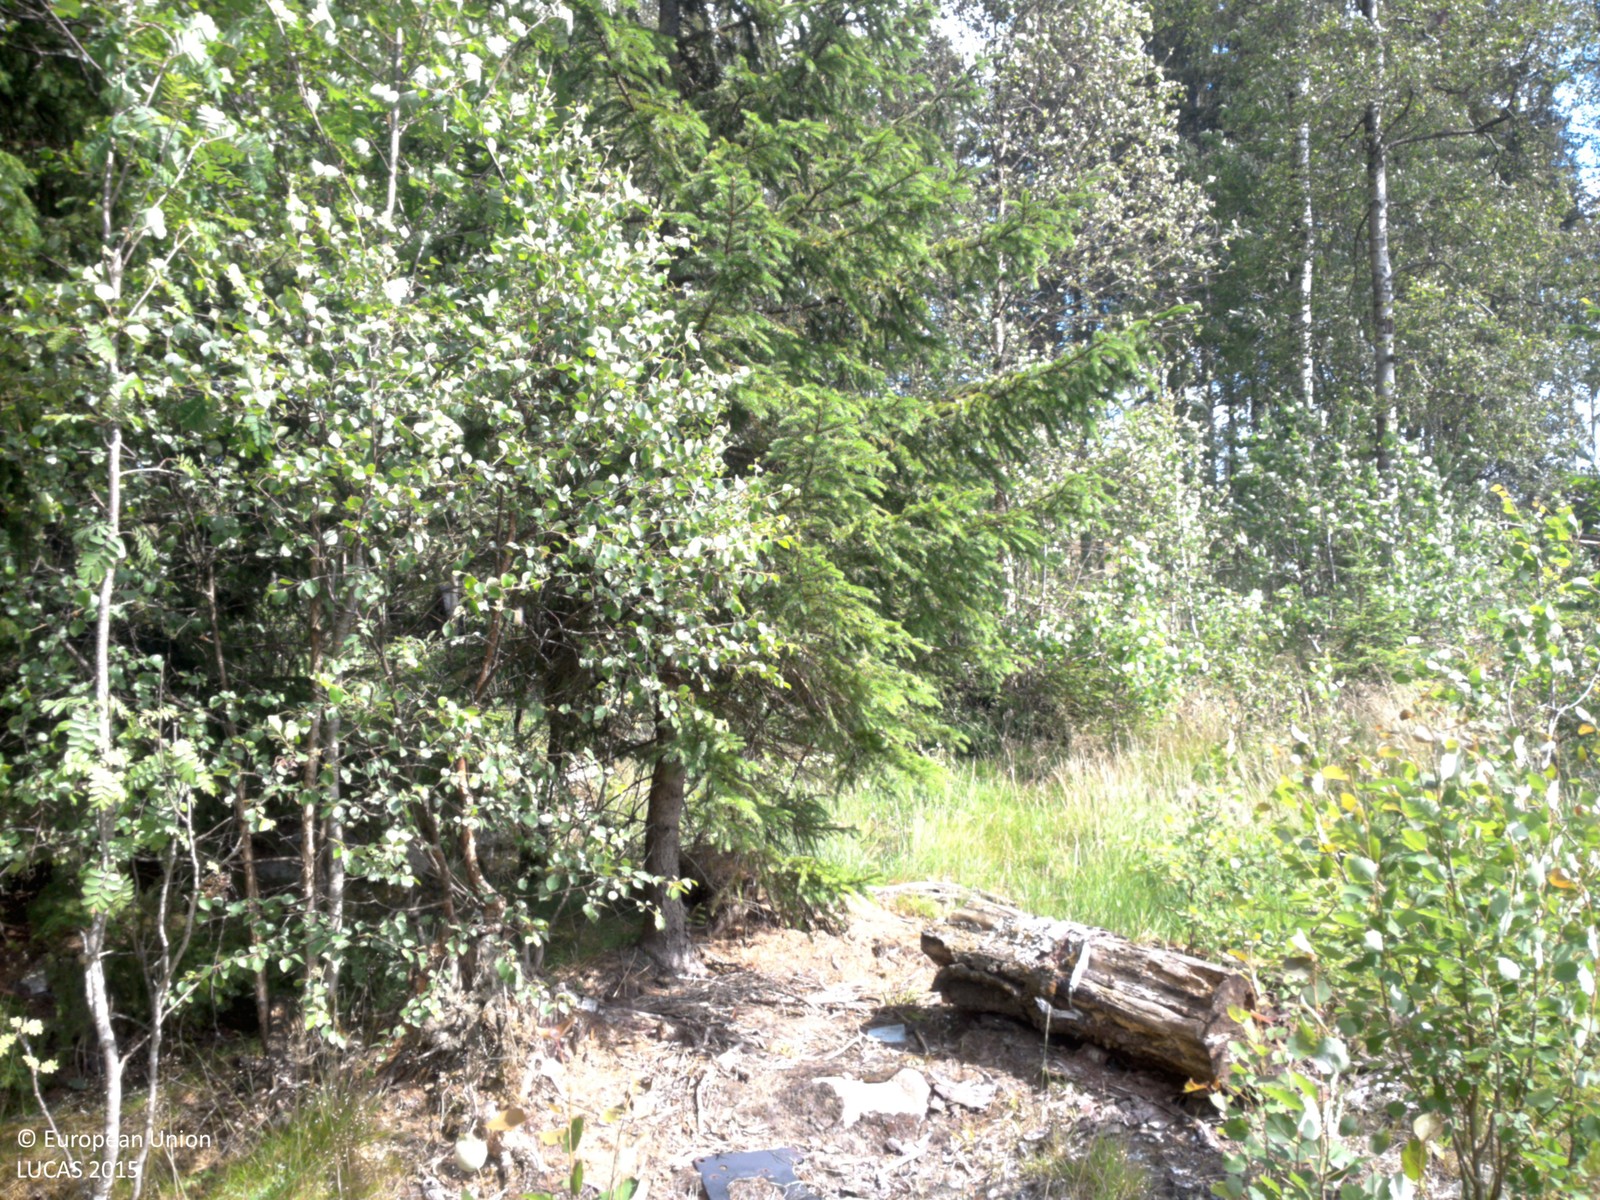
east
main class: Grassland
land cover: Grassland without tree/shrub cover
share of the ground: 50 - 75 %
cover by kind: herbaceous plants 65 %, unconsolidated bare surface 20 %, consolidated bare surface 15 %
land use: Residential
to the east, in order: Grassland without tree/shrub cover; Spruce dominated coniferous woodland; Inland fresh water bodies; Spruce dominated coniferous woodland; Shrubland with sparse tree cover
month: July
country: SE
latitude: 58.7801
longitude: 12.0193
